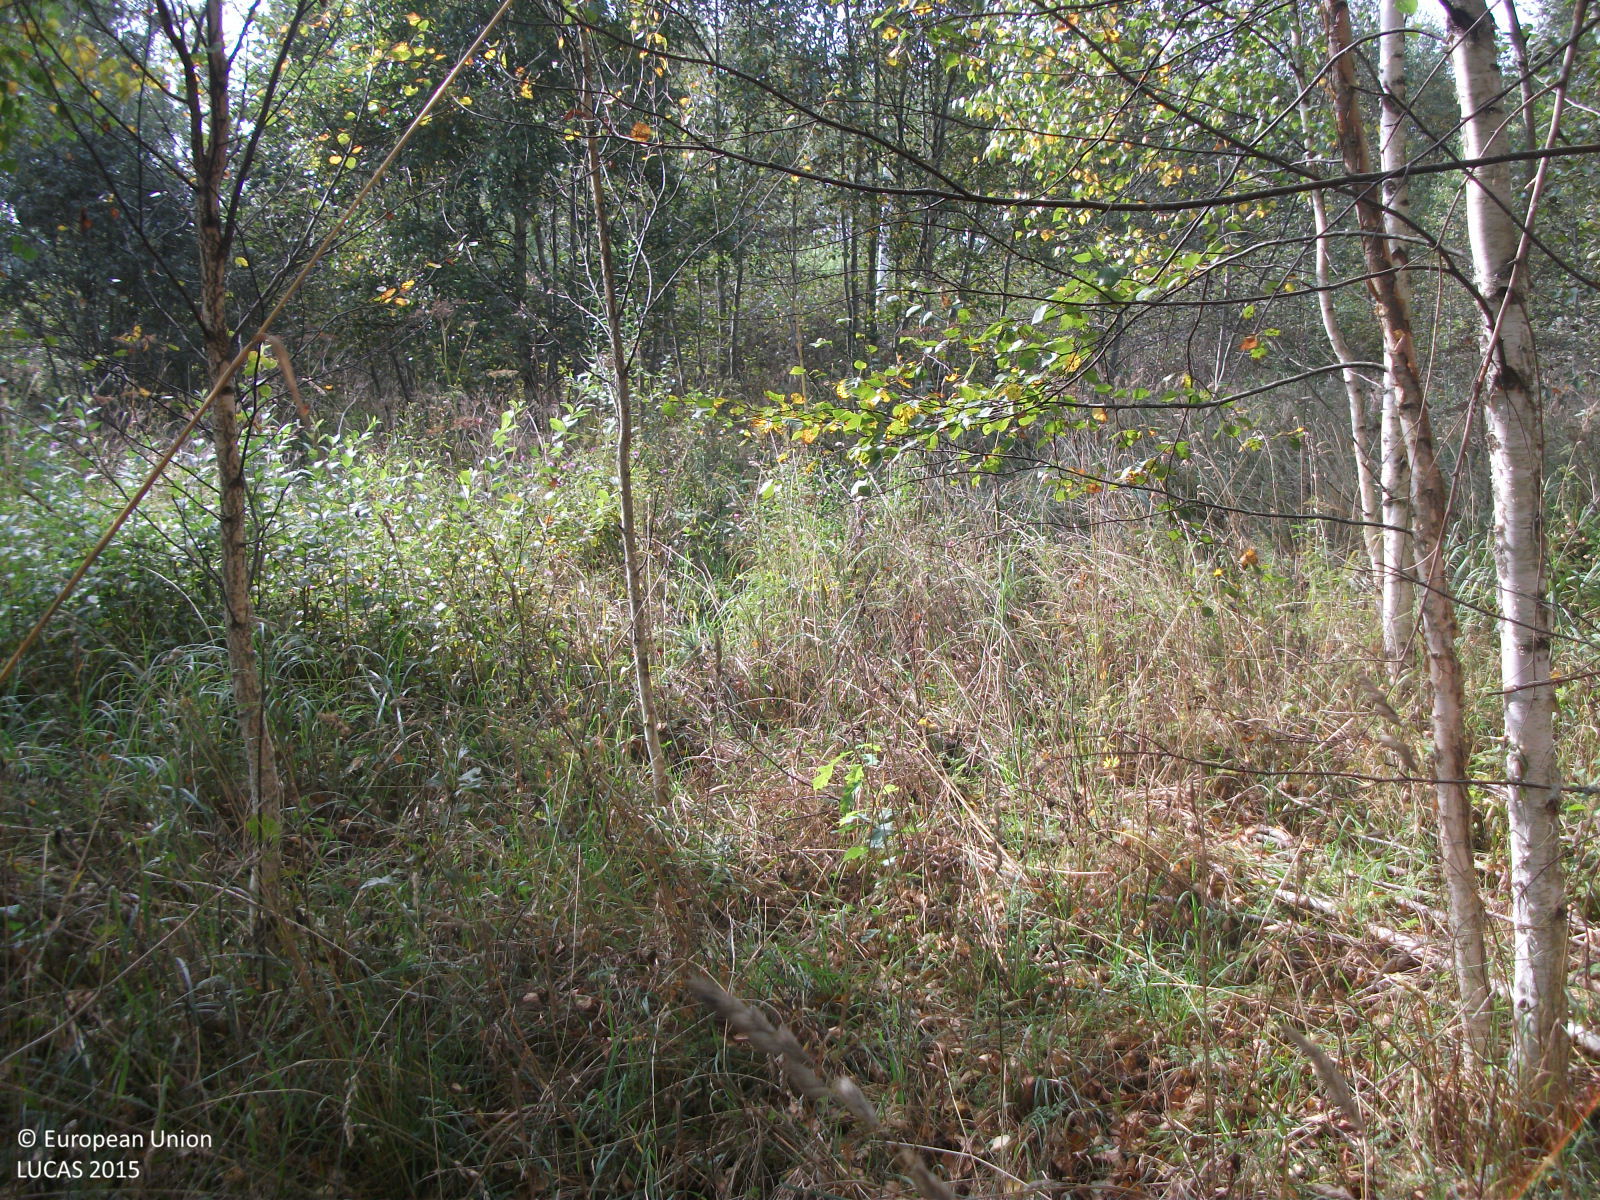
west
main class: Woodland
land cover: Broadleaved woodland
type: non-riverine alder, birch or aspen forest
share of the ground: > 75 %
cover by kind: broadleaved forest trees 90 %, shrubs 5 %, herbaceous plants 5 %
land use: Forestry
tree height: > 5 m
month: September
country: LV
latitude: 57.8438
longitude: 24.8715
